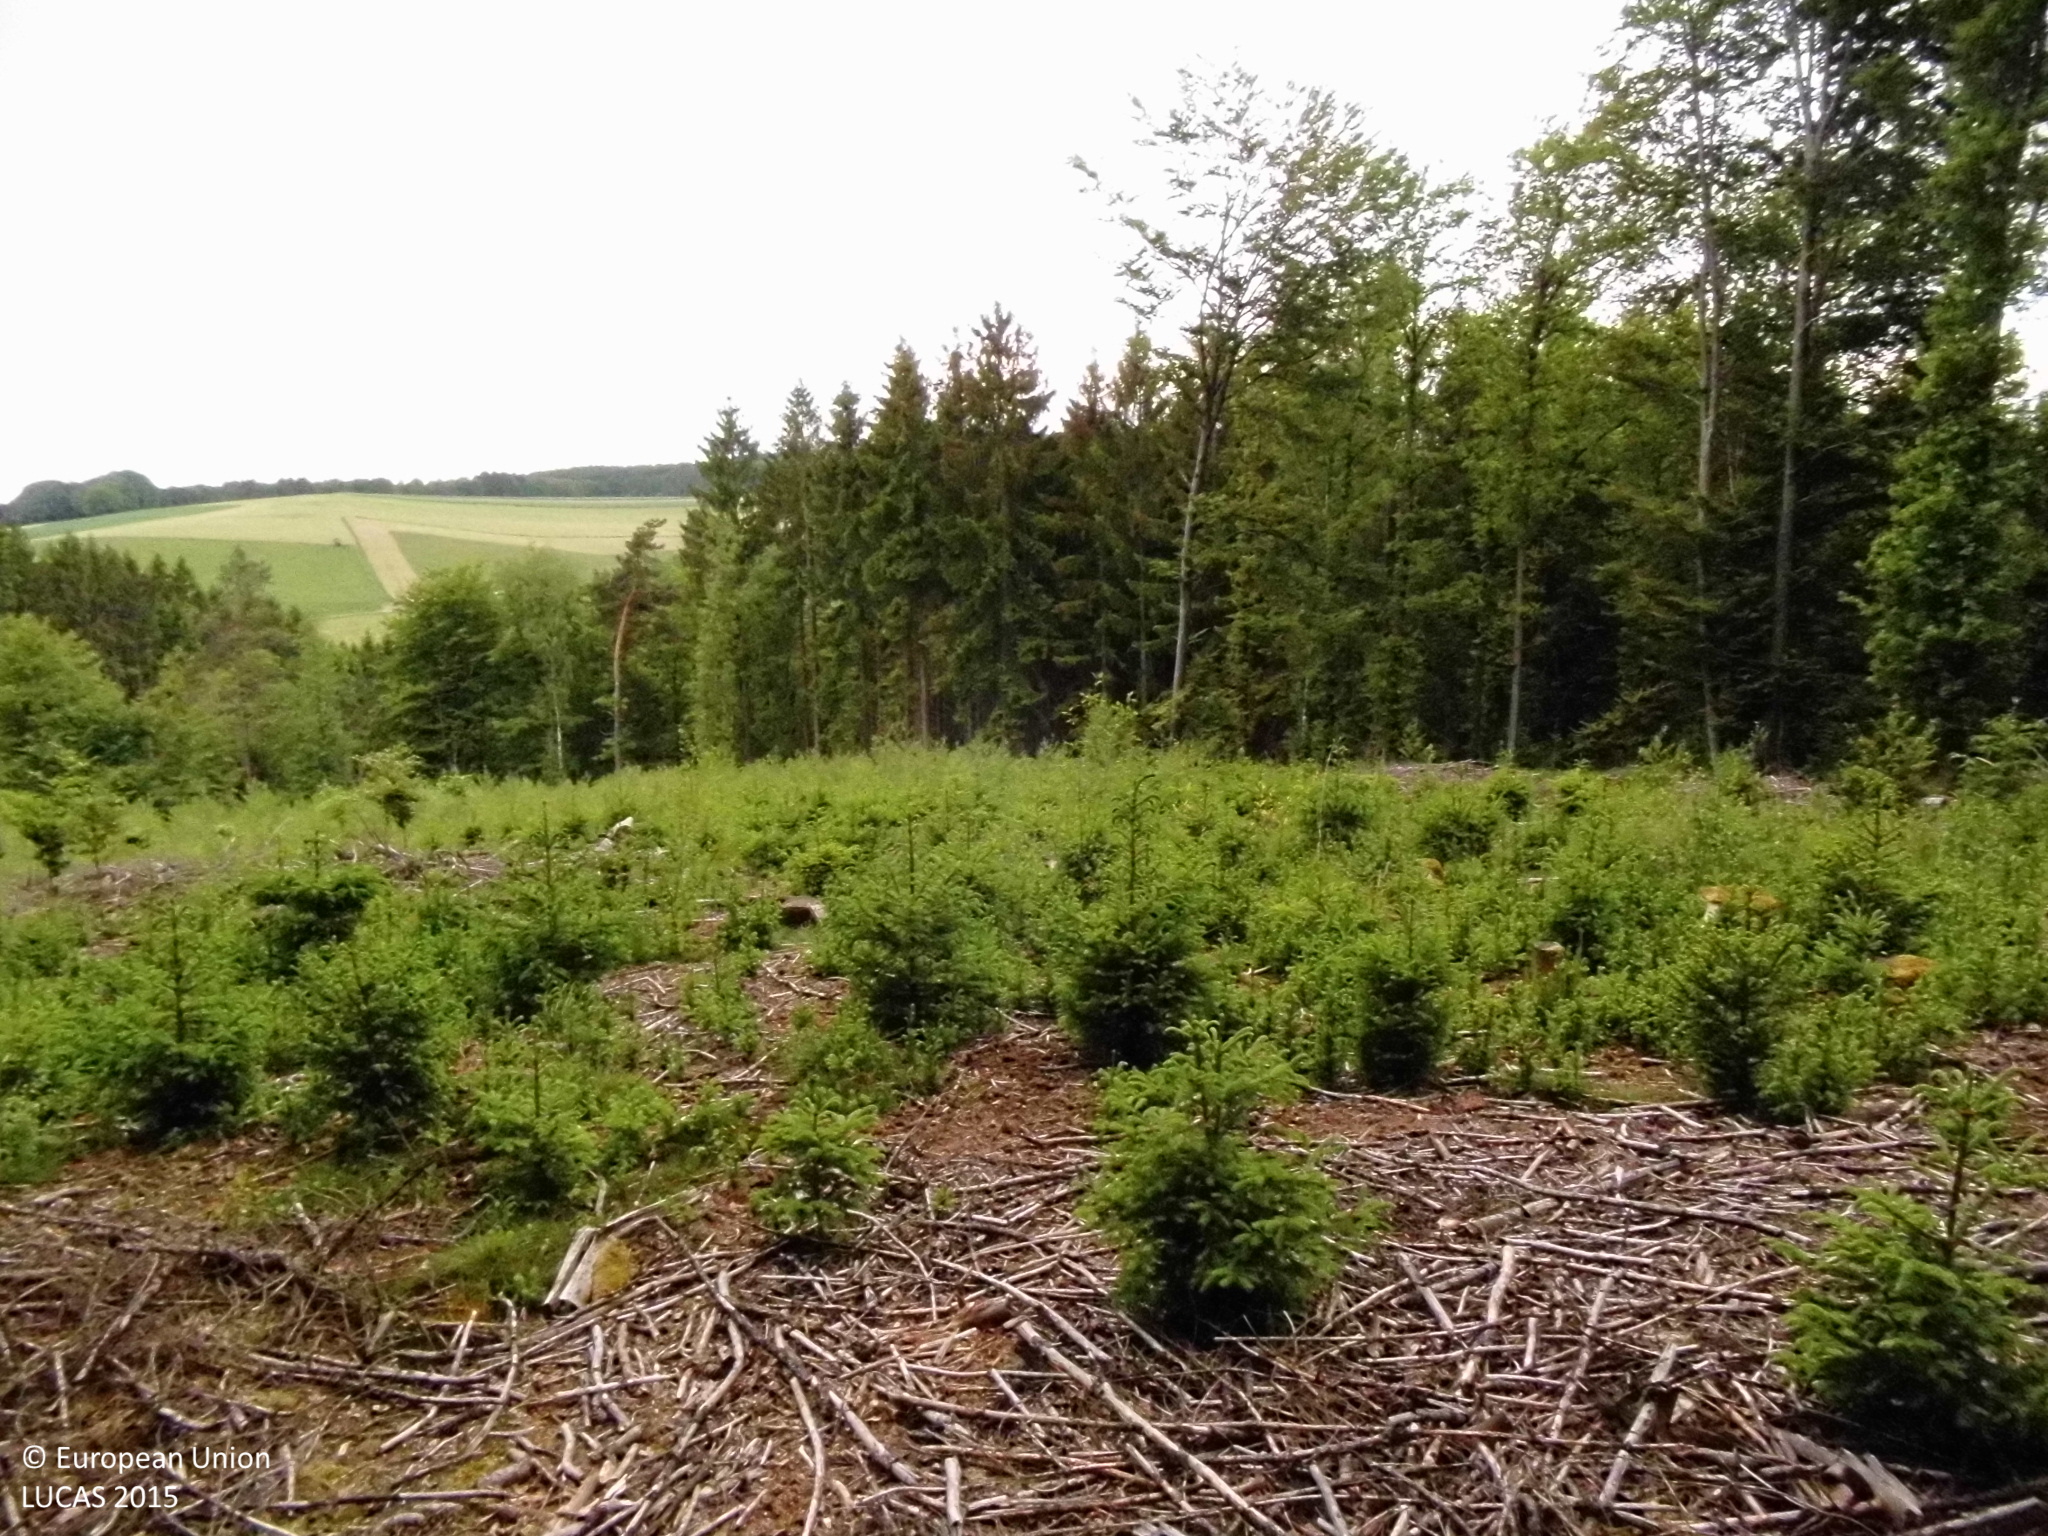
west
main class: Woodland
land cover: Other mixed woodland
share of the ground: > 75 %
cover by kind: coniferous forest trees 40 %, broadleaved forest trees 40 %, lichens and mosses 10 %, herbaceous plants 5 %, unconsolidated bare surface 5 %
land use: Forestry
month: May
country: DE
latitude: 50.9120
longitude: 7.4828
